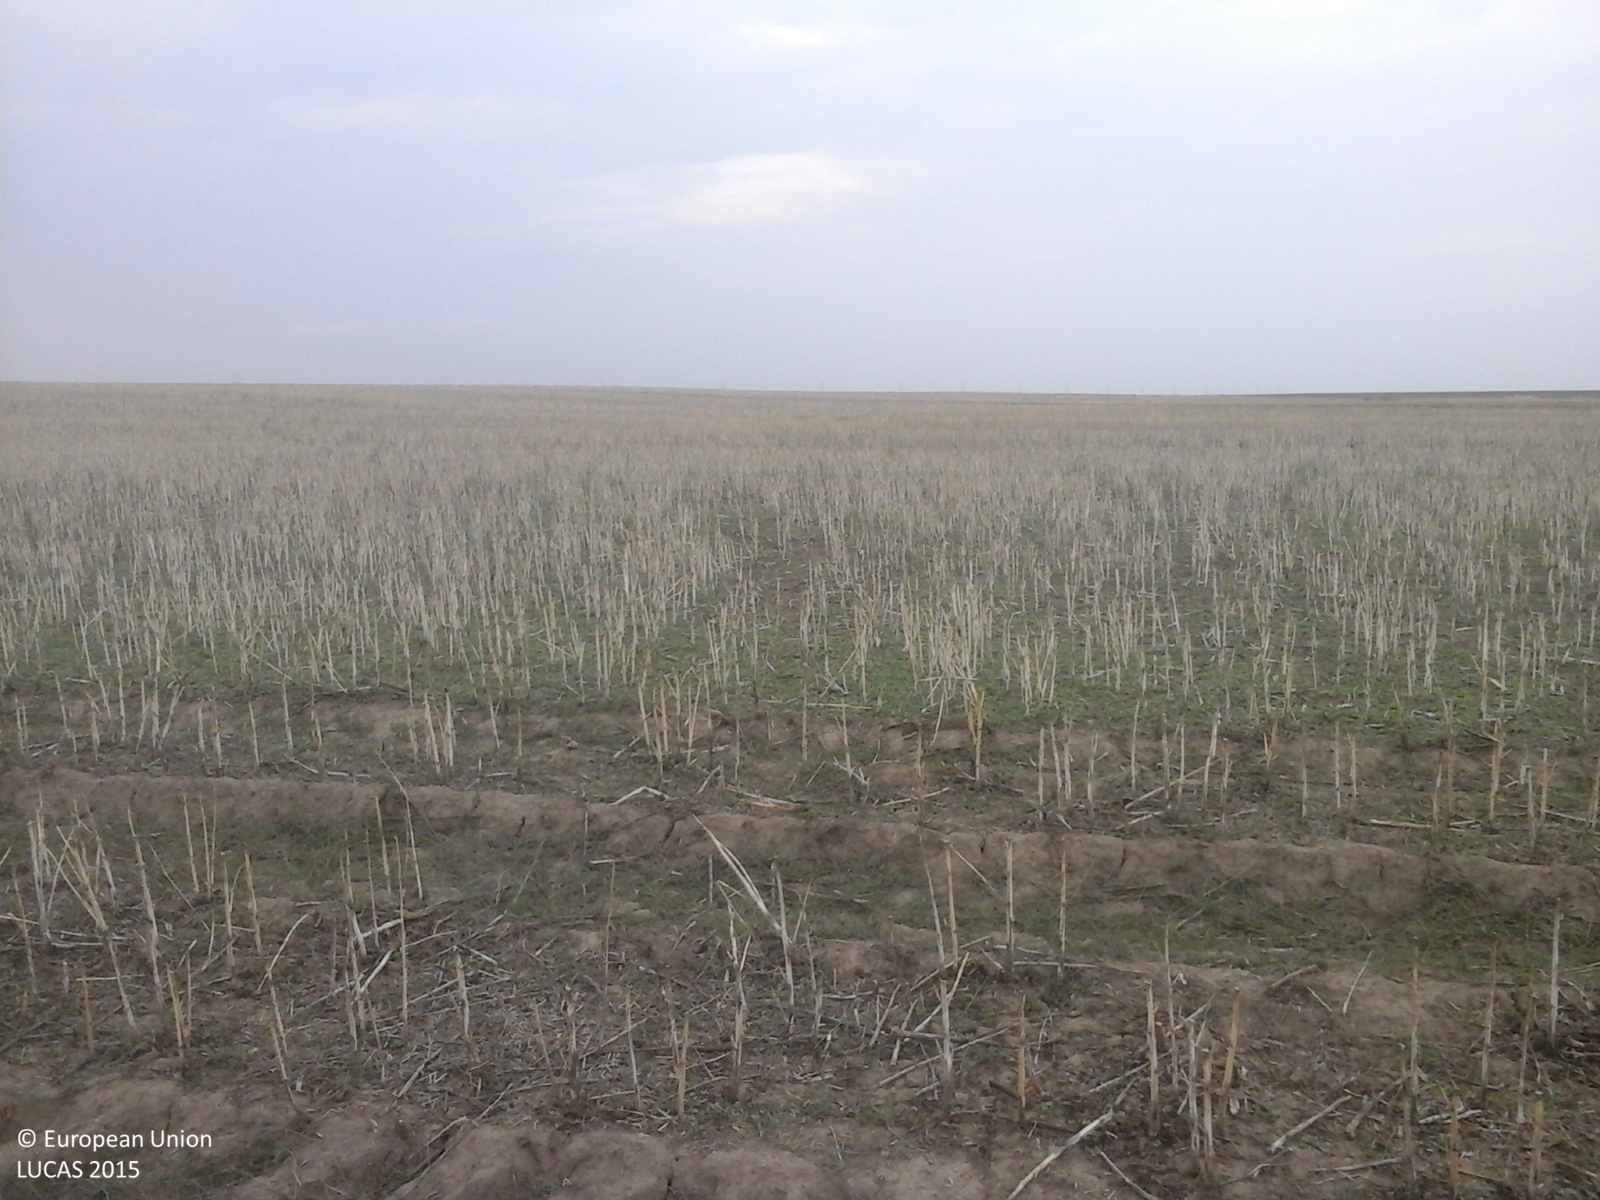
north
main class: Cropland
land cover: Rape and turnip rape
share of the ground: 10 - 25 %
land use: Agriculture (excluding fallow land and kitchen gardens)
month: August
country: RO
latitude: 46.2270
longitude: 21.4322
